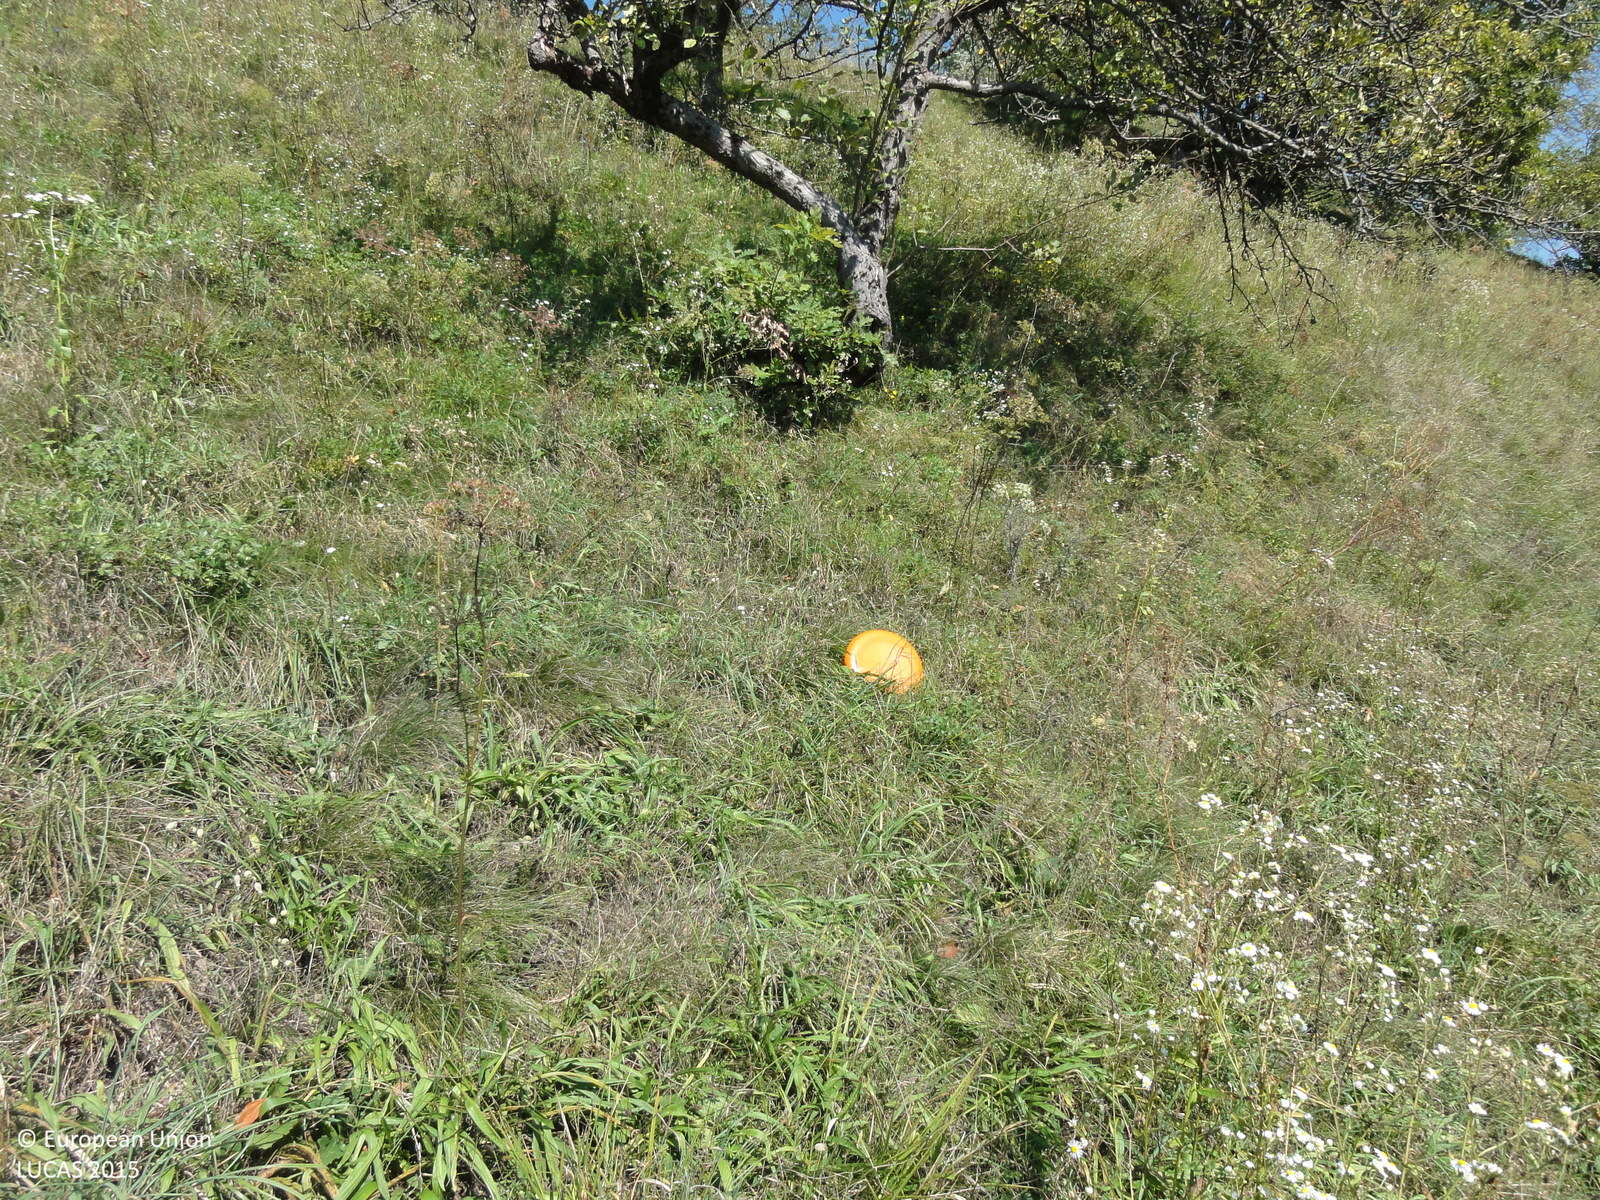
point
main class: Cropland
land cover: Apple fruit
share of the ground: 25 - 50 %
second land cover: Grassland without tree/shrub cover
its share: > 75 %
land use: Agriculture (excluding fallow land and kitchen gardens)
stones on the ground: < 10 %
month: September
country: SI
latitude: 46.0428
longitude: 15.2308
